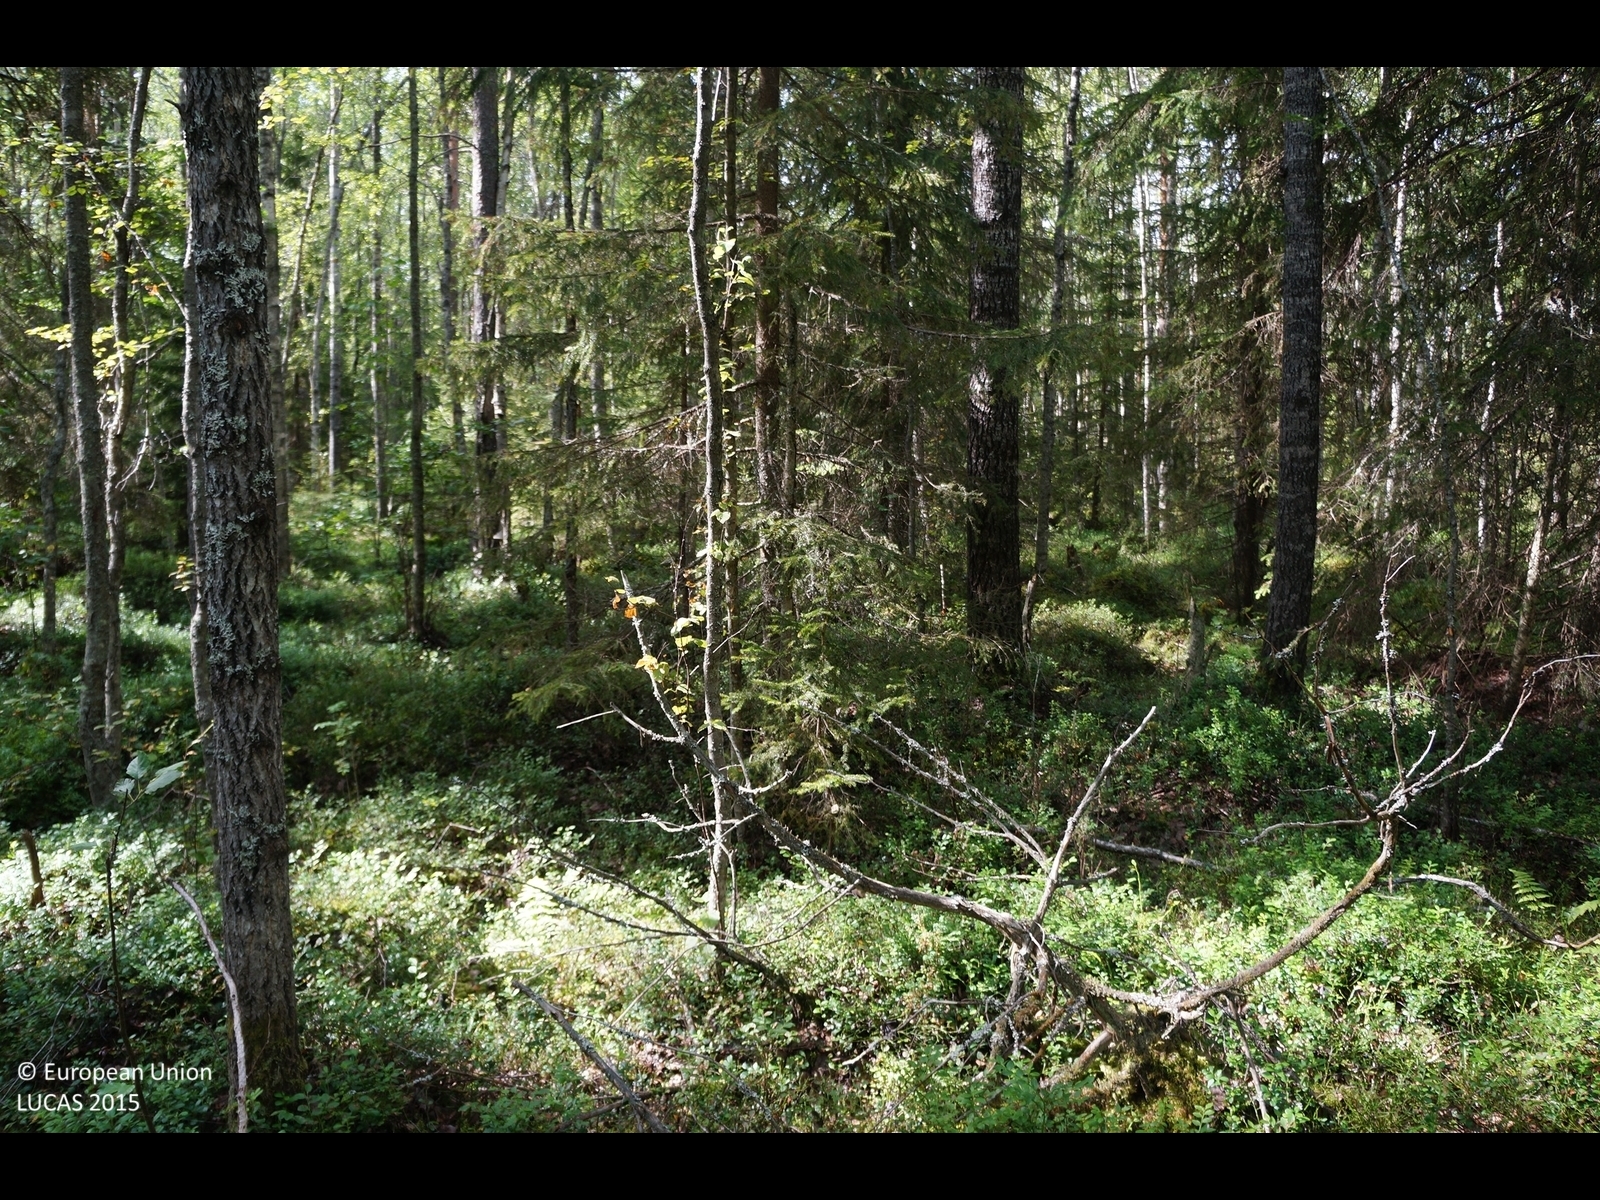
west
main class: Woodland
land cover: Spruce dominated mixed woodland
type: boreal forest
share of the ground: 50 - 75 %
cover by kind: coniferous forest trees 40 %, broadleaved forest trees 30 %, shrubs 25 %, lichens and mosses 5 %
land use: Forestry
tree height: > 5 m
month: August
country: FI
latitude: 64.5885
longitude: 24.7560
